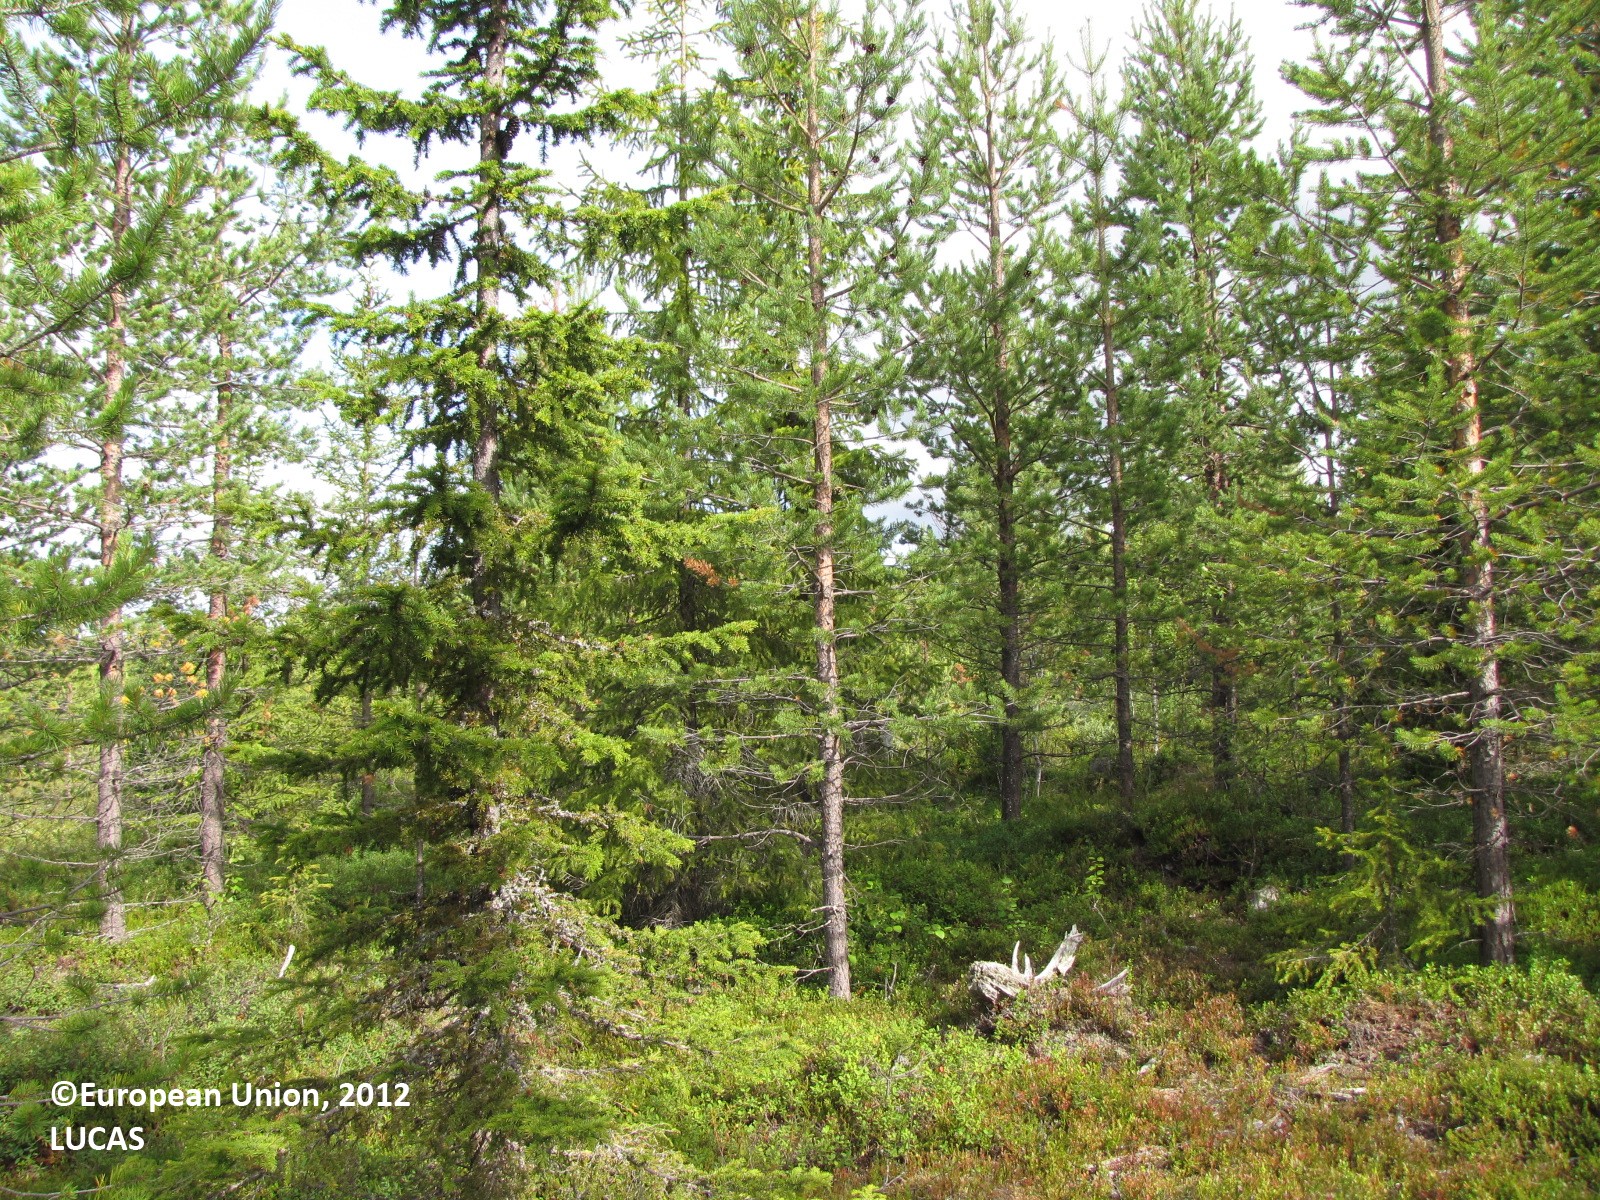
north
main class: Woodland
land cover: Pine dominated coniferous woodland
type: boreal forest
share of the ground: 25 - 50 %
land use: Forestry
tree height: > 5 m
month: August
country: FI
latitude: 66.8913
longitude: 24.6317
